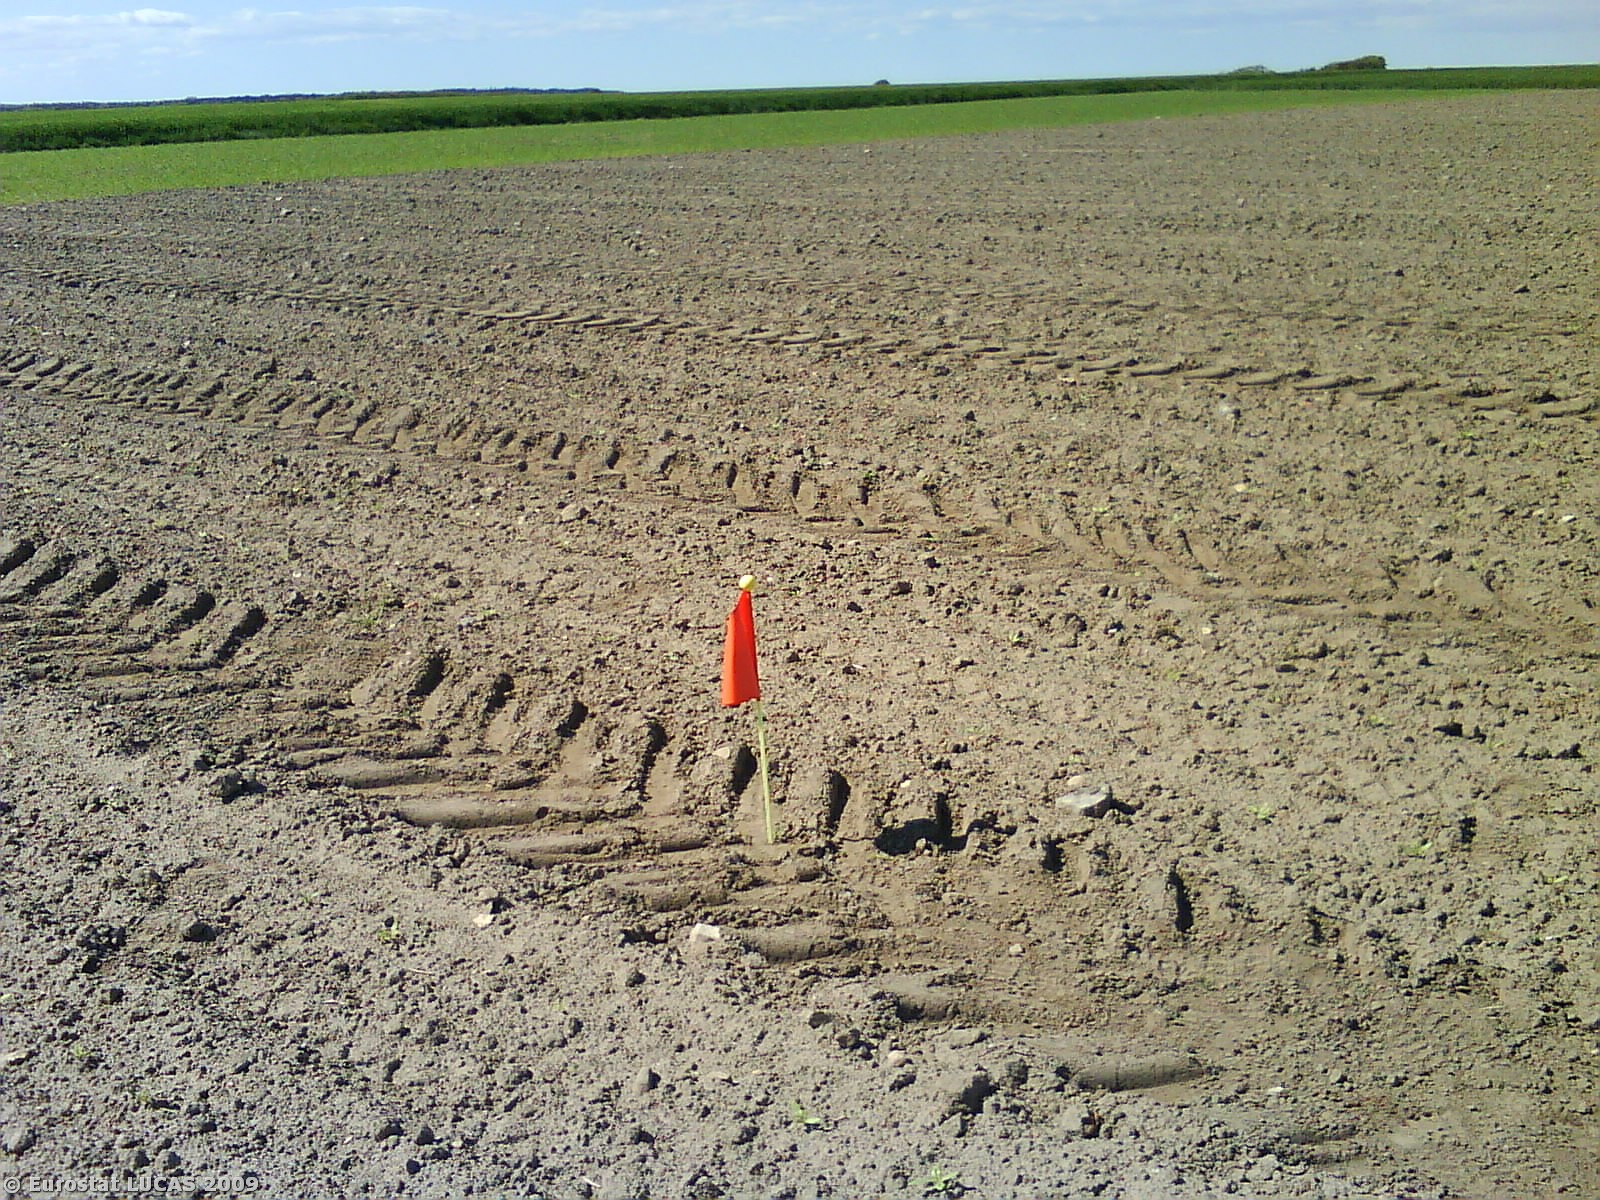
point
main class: Cropland
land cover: Sugar beet
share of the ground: < 10 %
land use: Agriculture (excluding fallow land and kitchen gardens)
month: May
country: DK
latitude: 56.5085
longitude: 10.8601
